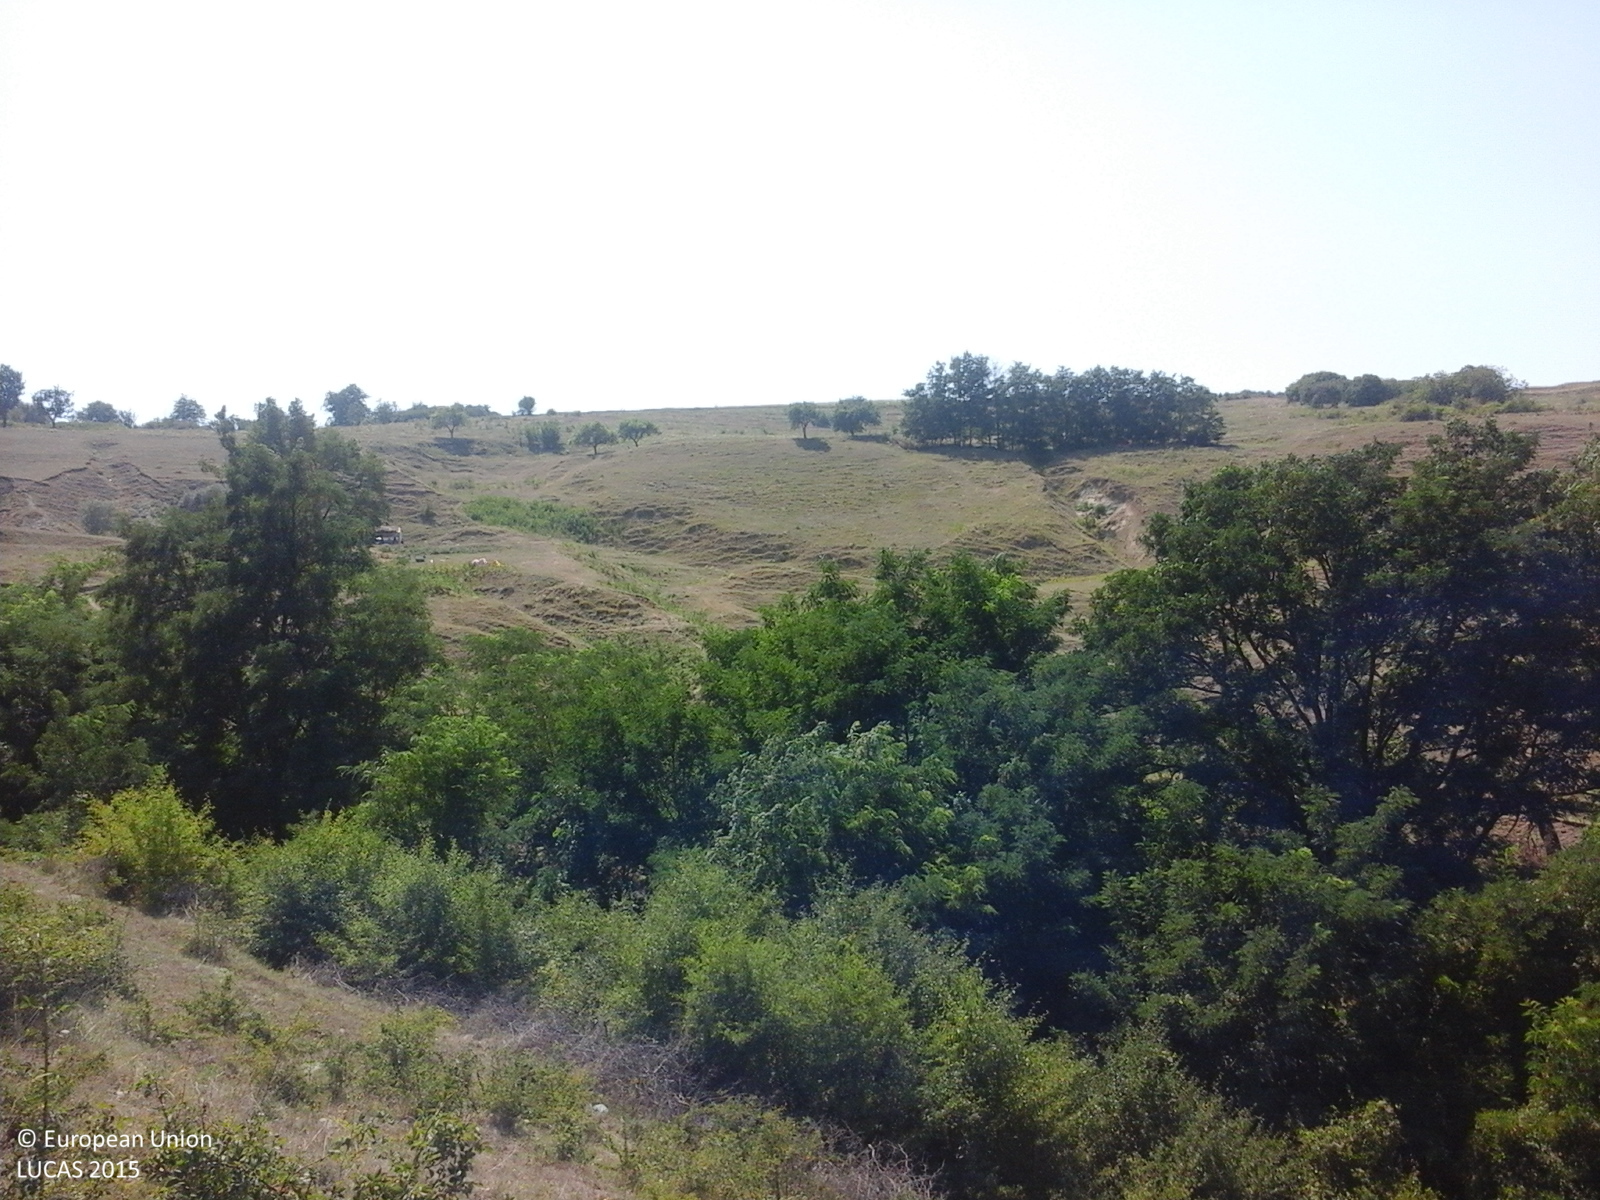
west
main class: Shrubland
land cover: Shrubland with sparse tree cover
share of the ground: > 75 %
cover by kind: herbaceous plants 70 %, shrubs 25 %, broadleaved forest trees 5 %
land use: Agriculture (excluding fallow land and kitchen gardens)
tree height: < 5 m
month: July
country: RO
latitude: 46.2935
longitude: 27.2765
